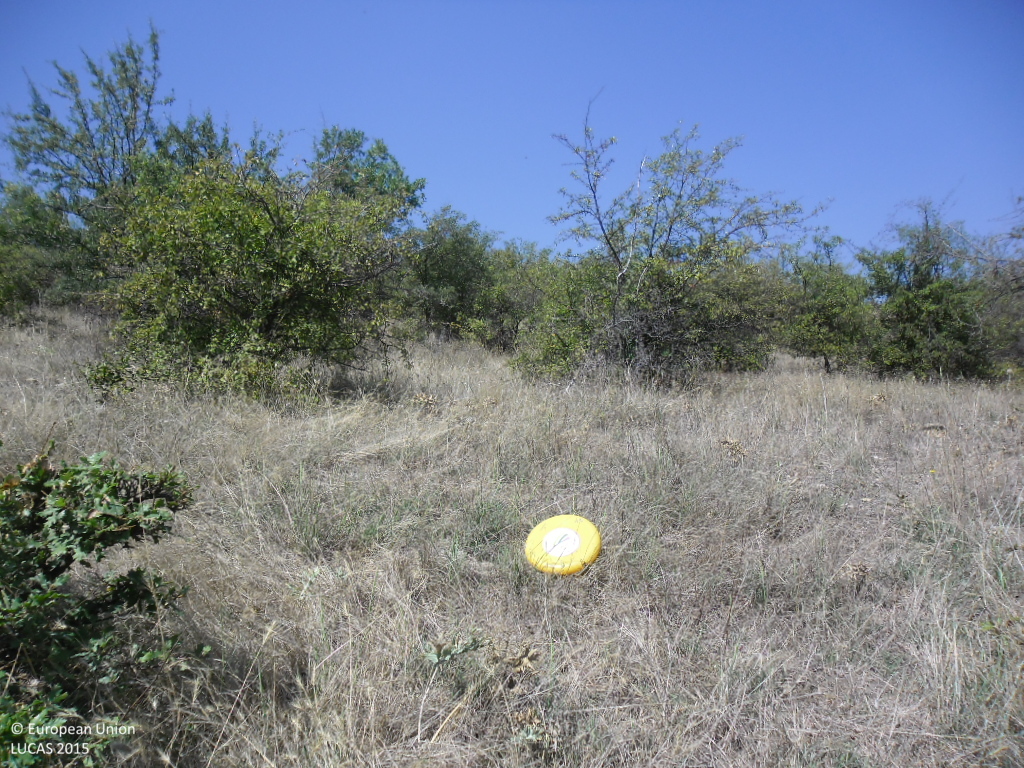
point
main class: Grassland
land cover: Grassland with sparse tree/shrub cover
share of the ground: > 75 %
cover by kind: herbaceous plants 90 %, broadleaved forest trees 5 %, shrubs 5 %
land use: Agriculture (excluding fallow land and kitchen gardens)
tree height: < 5 m
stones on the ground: < 10 %
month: August
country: BG
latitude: 42.0127
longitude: 23.0038
